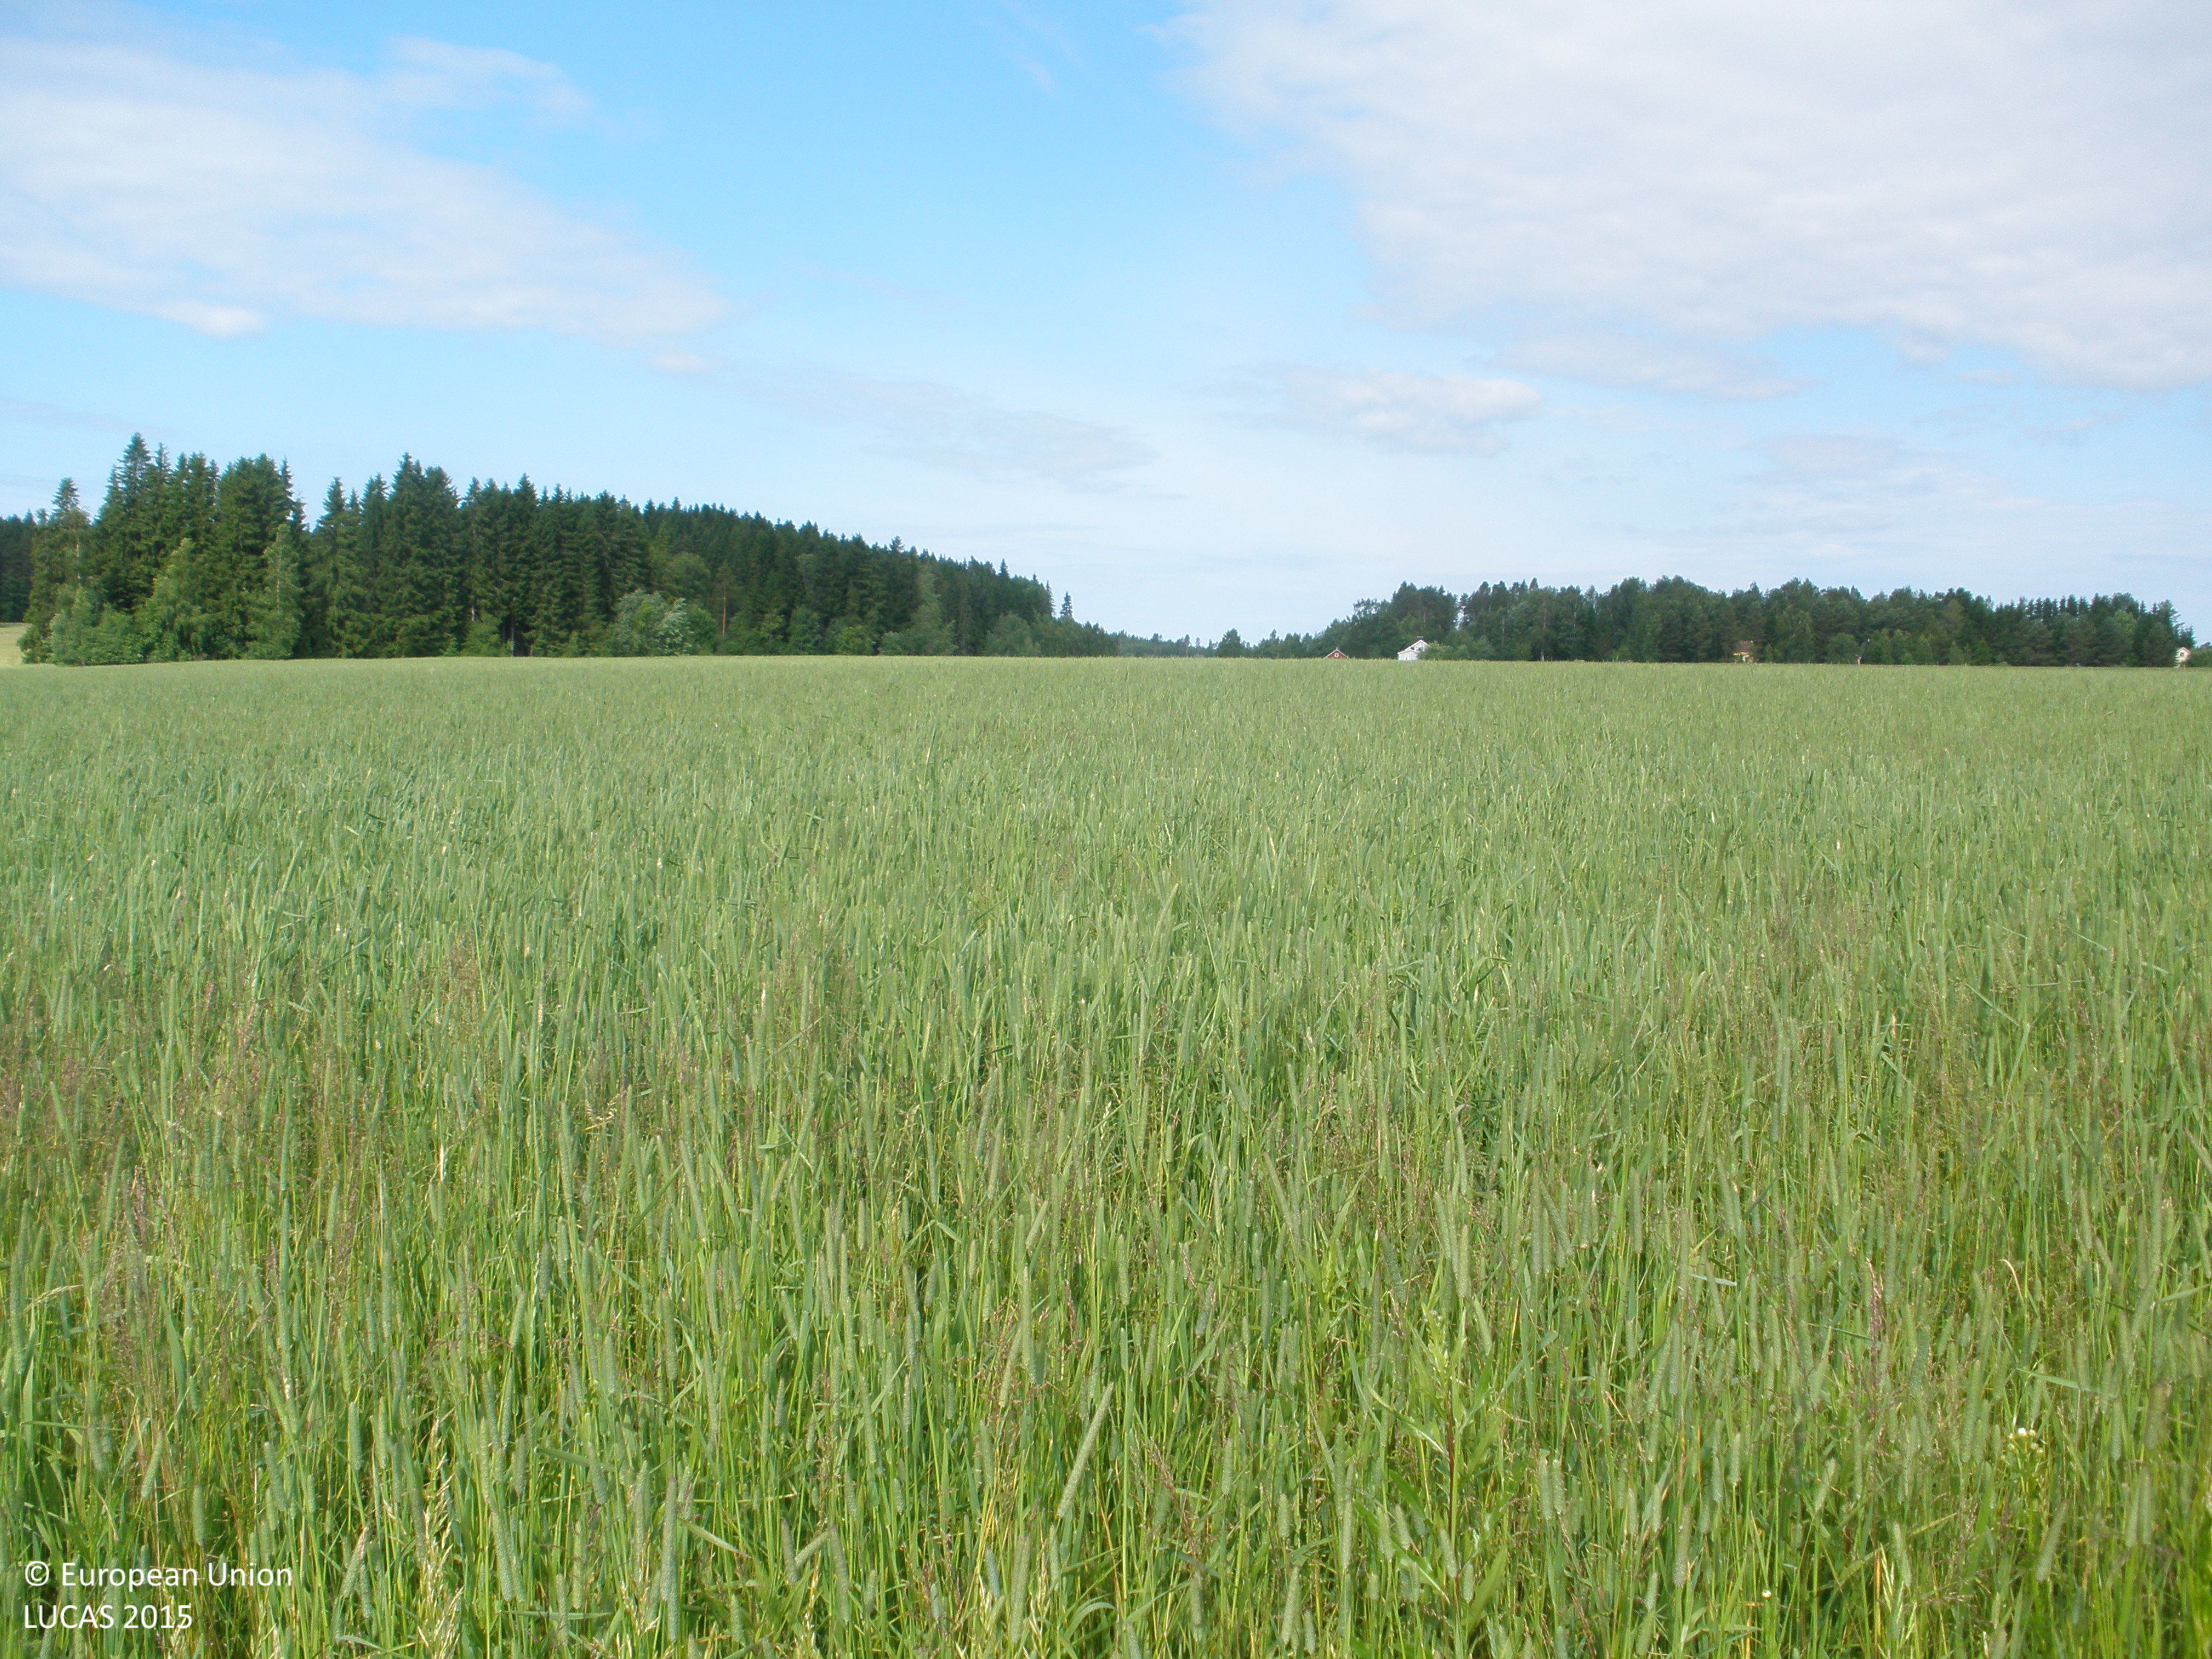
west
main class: Cropland
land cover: Mixed cereals for fodder
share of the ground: > 75 %
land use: Agriculture (excluding fallow land and kitchen gardens)
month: July
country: FI
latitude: 60.8731
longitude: 23.2107
